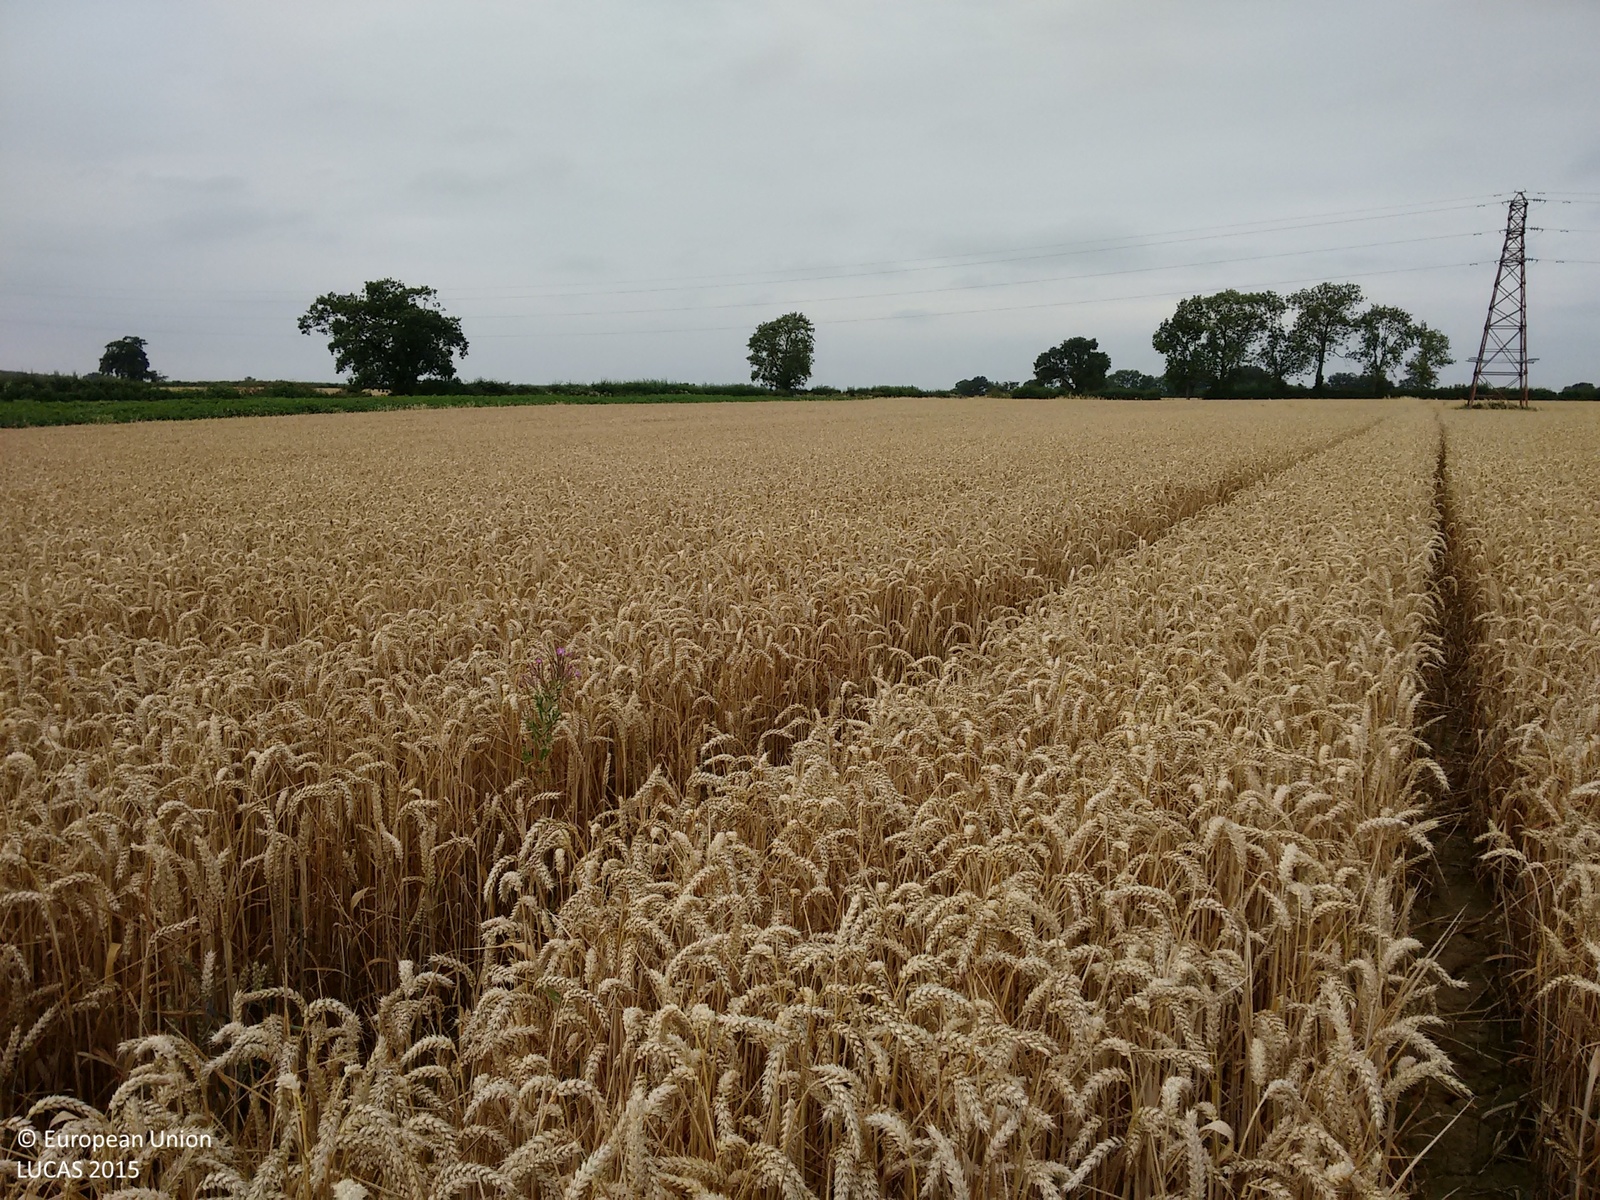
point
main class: Cropland
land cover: Common wheat
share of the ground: > 75 %
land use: Agriculture (excluding fallow land and kitchen gardens)
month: August
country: GB
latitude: 52.2987
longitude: -0.8199
